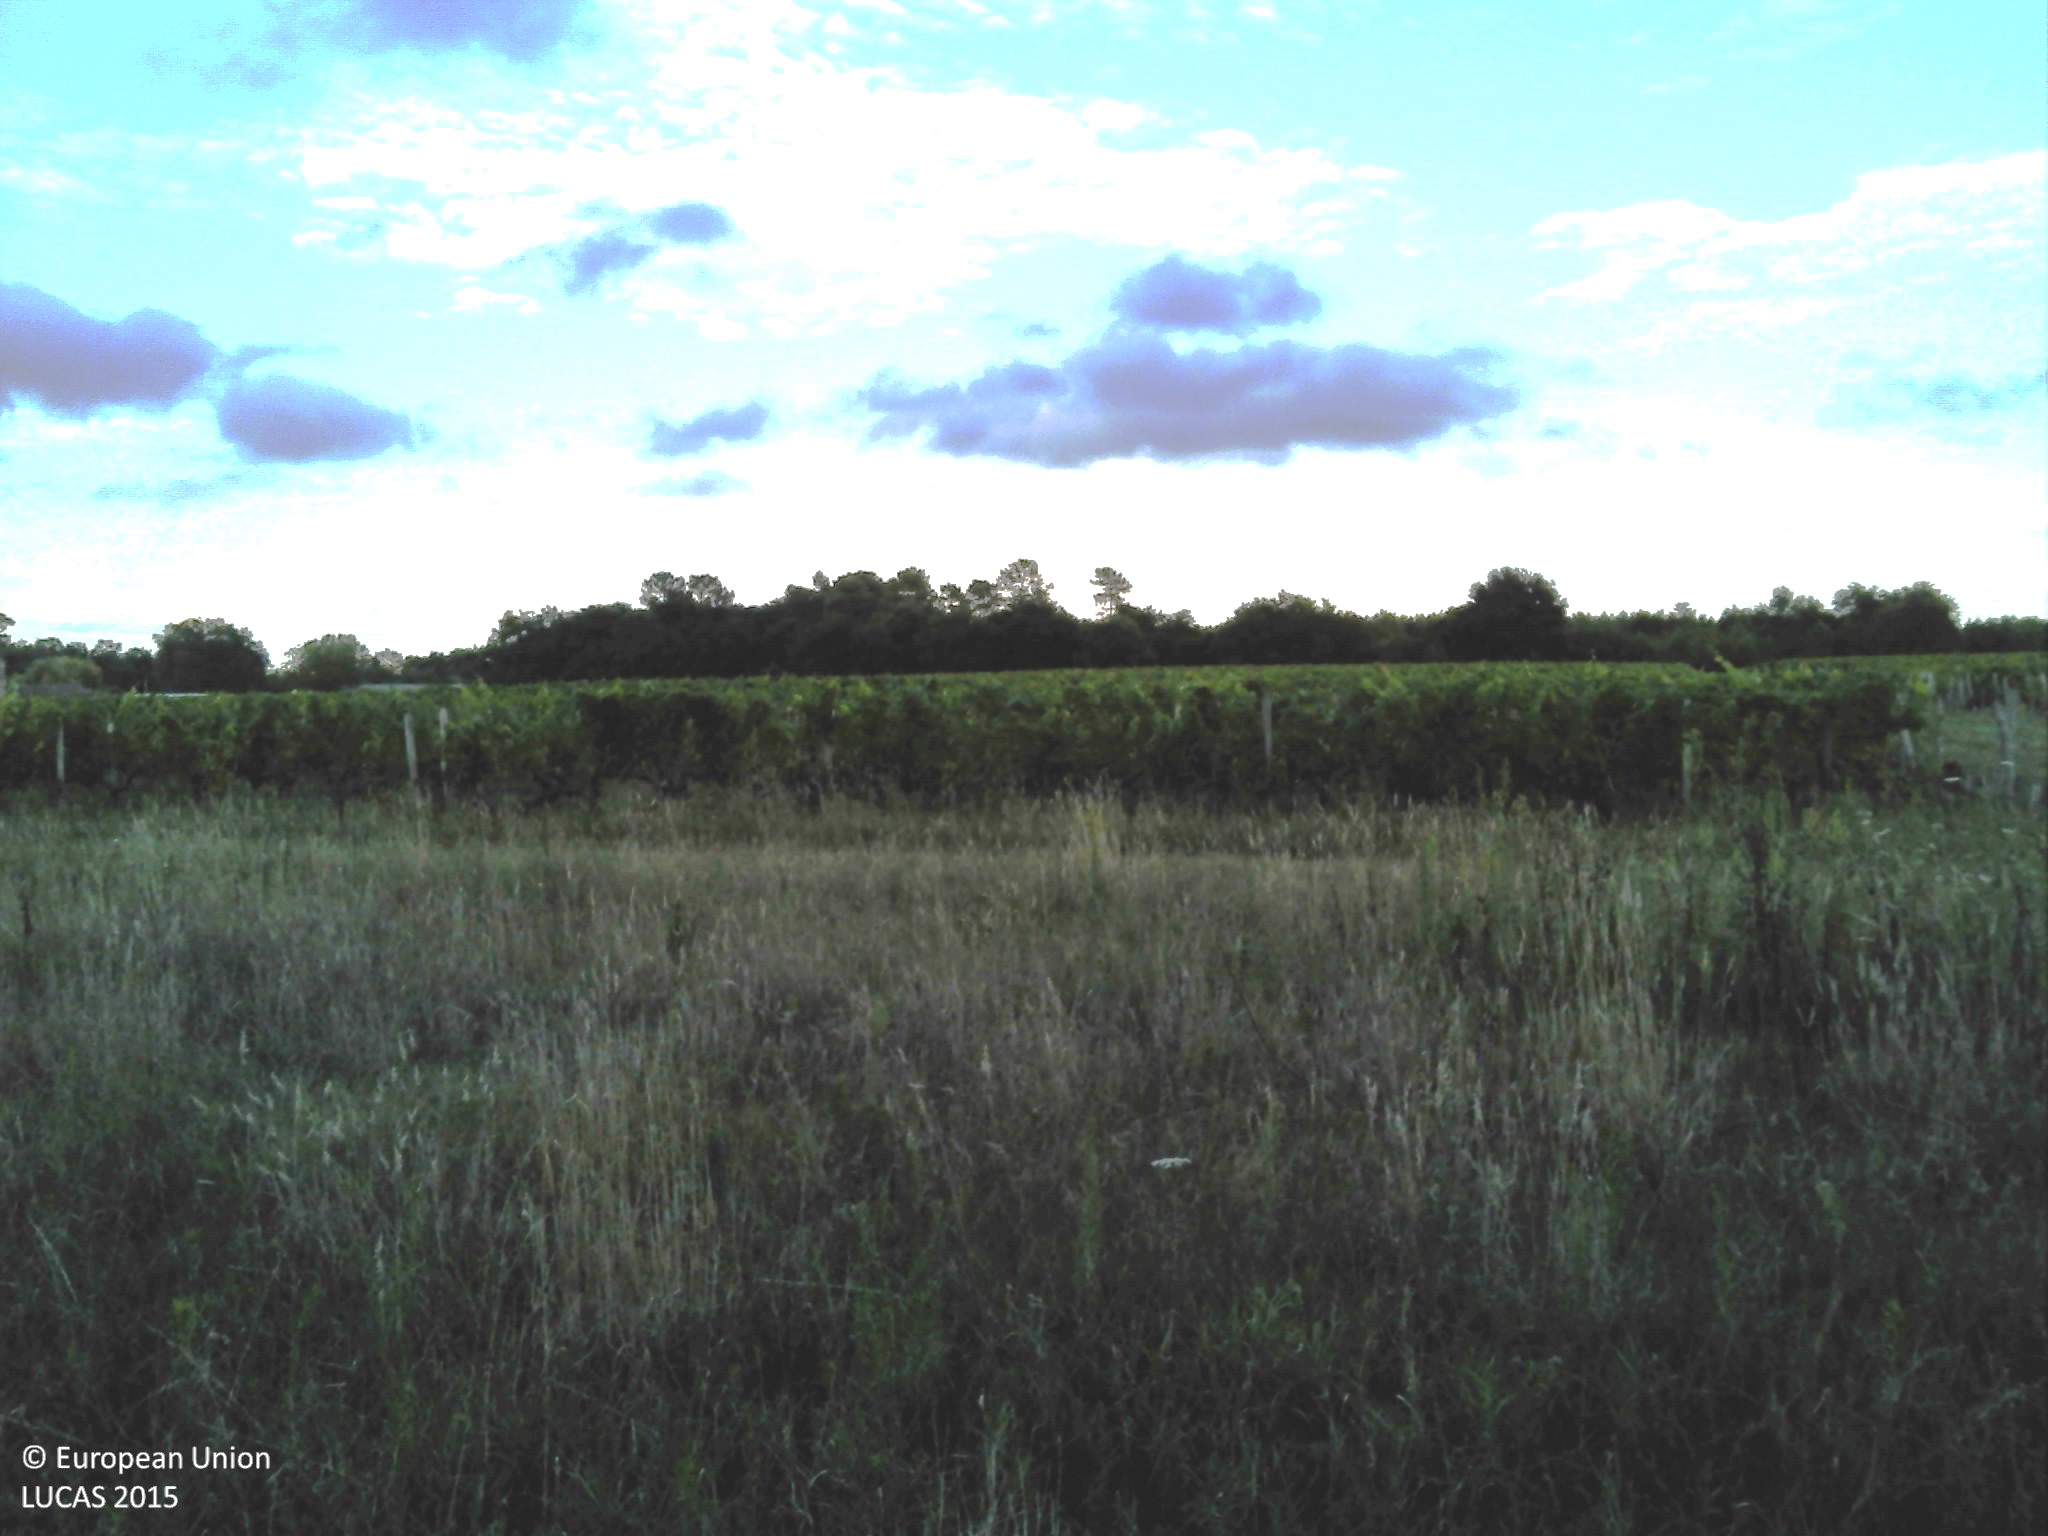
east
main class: Grassland
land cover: Grassland without tree/shrub cover
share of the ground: > 75 %
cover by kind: herbaceous plants 100 %
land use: Agriculture (excluding fallow land and kitchen gardens)
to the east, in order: Grassland without tree/shrub cover; Tracks; Vineyards; Tracks; Vineyards
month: August
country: FR
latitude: 45.2151
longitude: -0.8598
